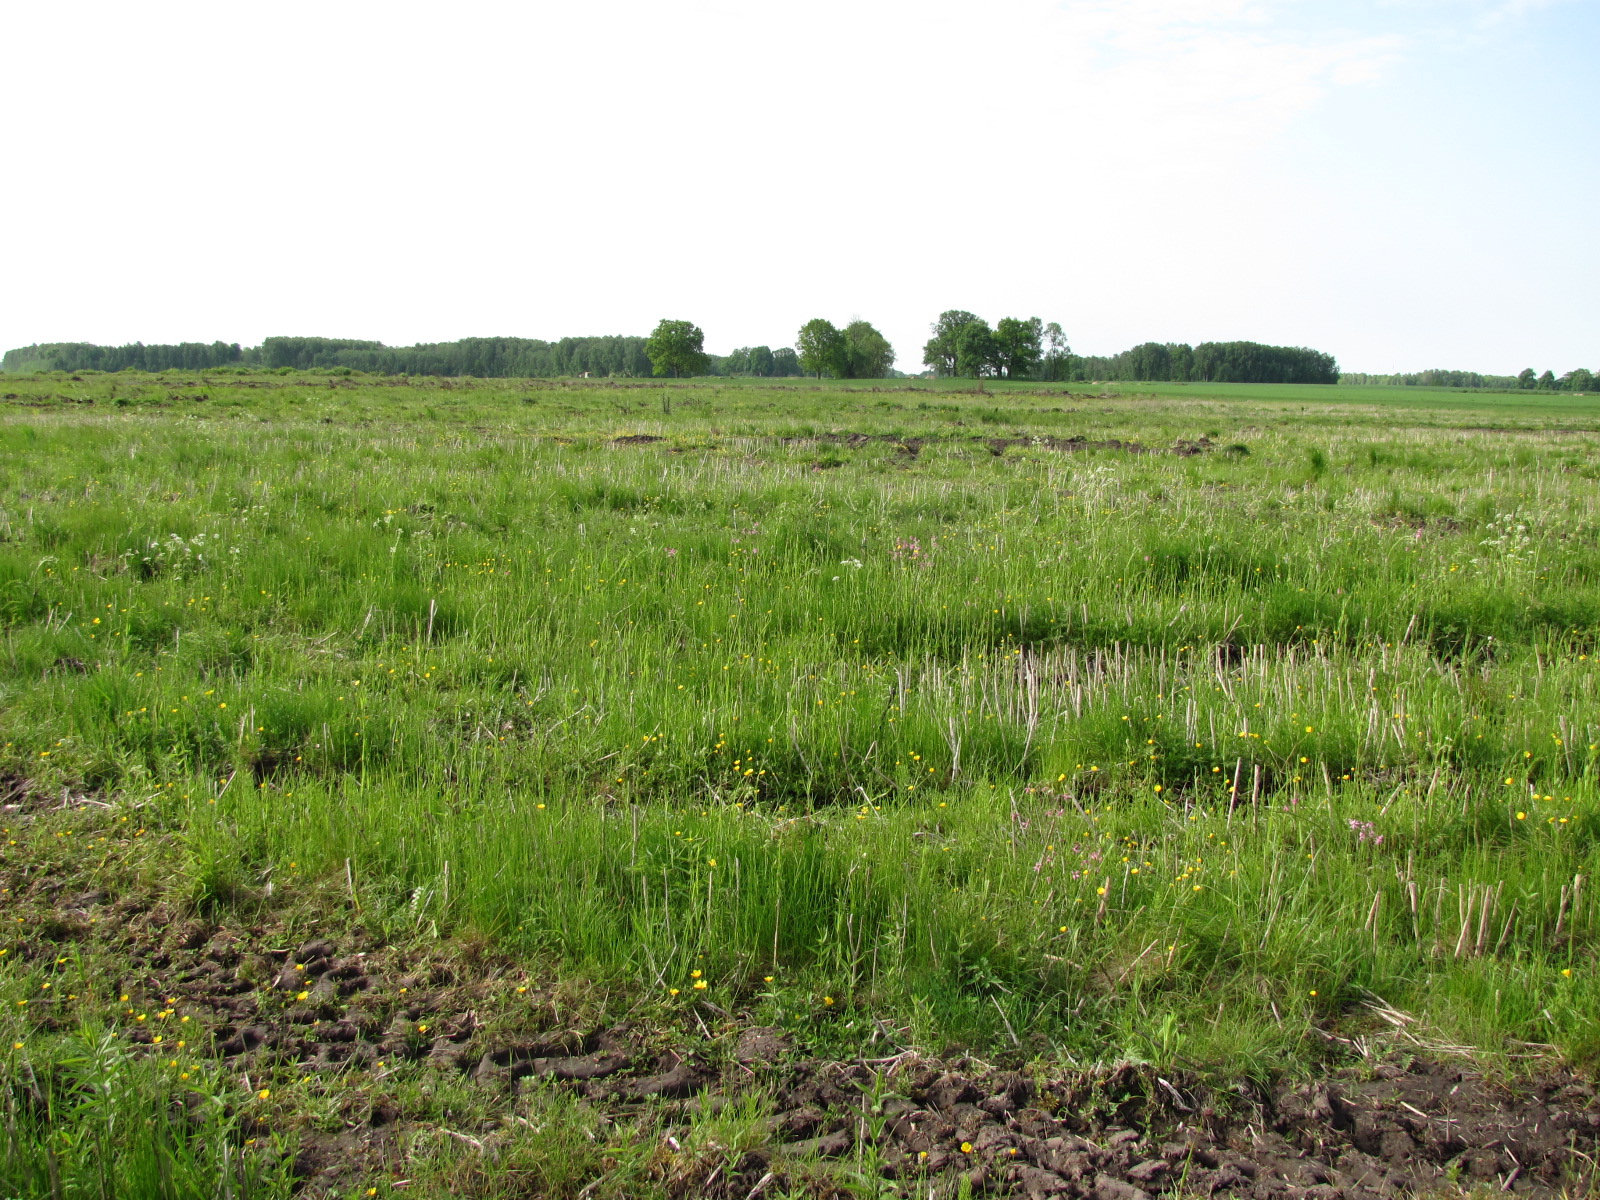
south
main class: Grassland
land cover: Spontaneously vegetated surfaces
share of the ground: 50 - 75 %
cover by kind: herbaceous plants 70 %, unconsolidated bare surface 30 %
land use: Fallow land
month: May
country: LV
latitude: 56.5354
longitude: 24.1203
